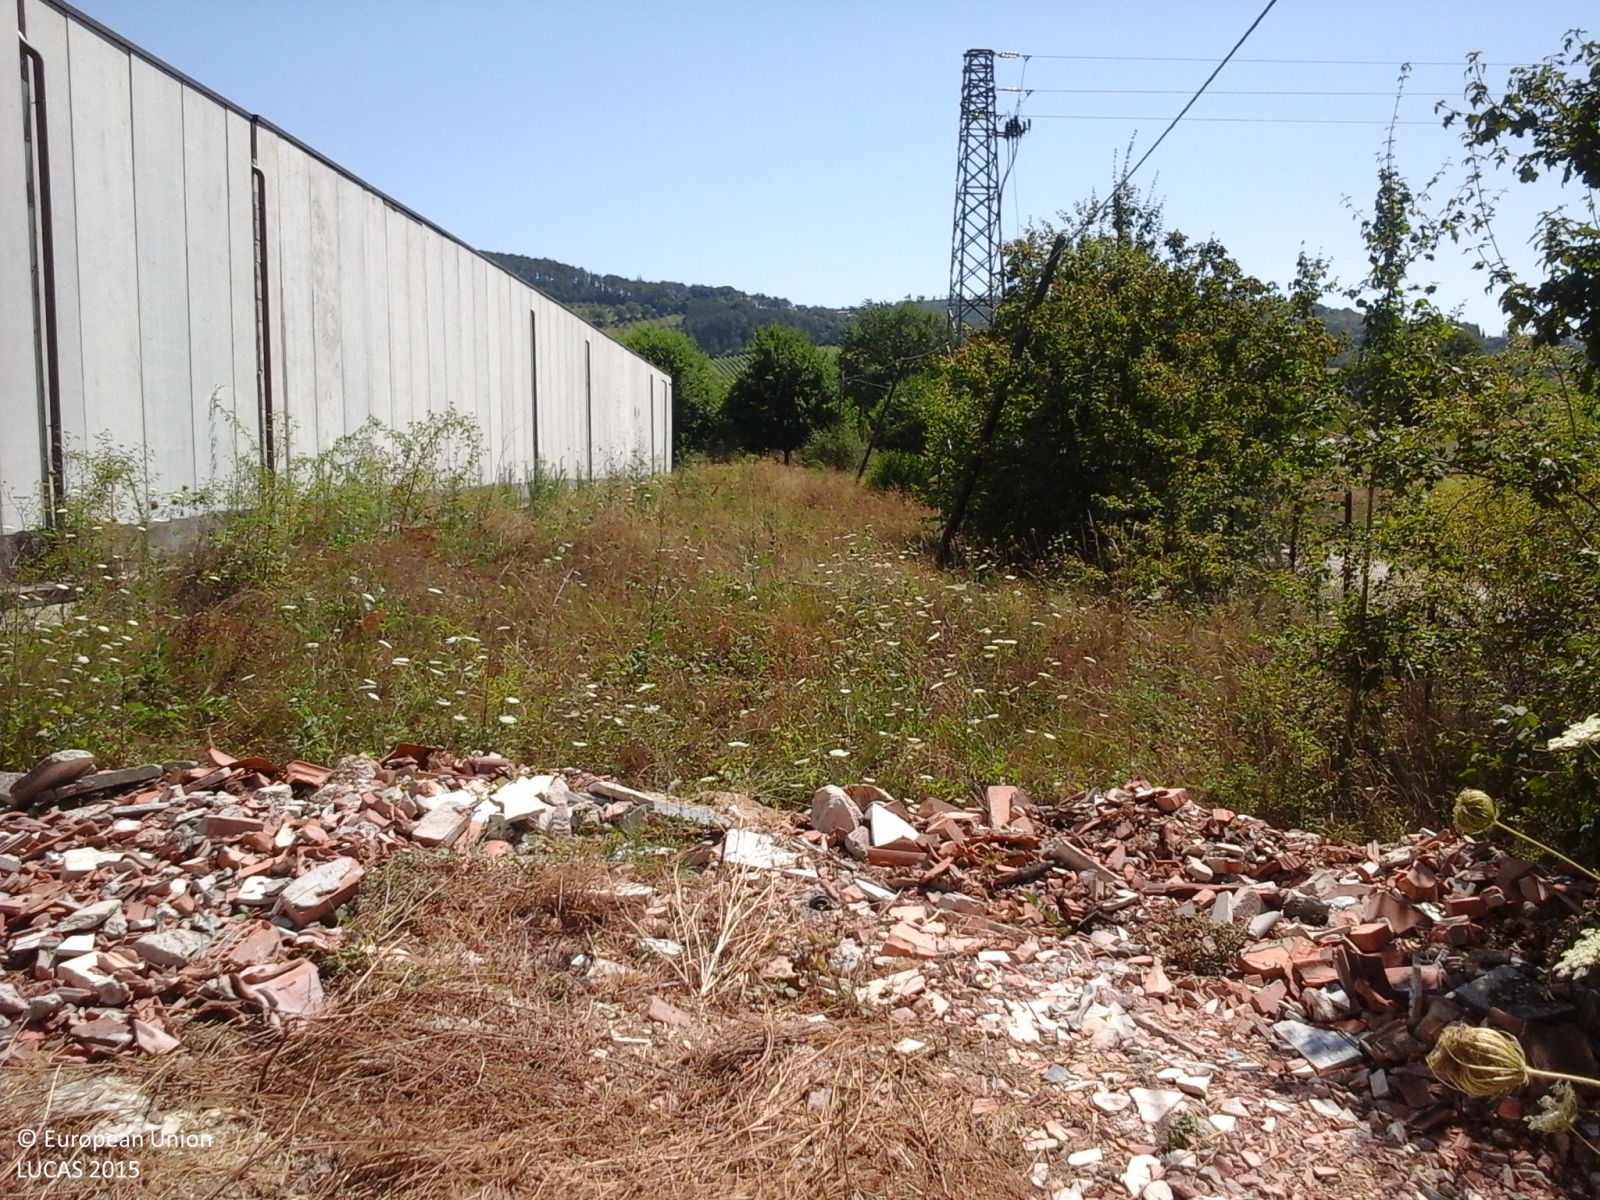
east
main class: Grassland
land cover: Grassland with sparse tree/shrub cover
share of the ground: > 75 %
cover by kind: herbaceous plants 95 %, broadleaved forest trees 5 %
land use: Community services
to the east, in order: Grassland with sparse tree/shrub cover; Fences; Lines of trees; Fences; Other fresh vegetables; Fences; Tracks; Cherry fruit; Grassland without tree/shrub cover
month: August
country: IT
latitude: 43.4597
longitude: 12.2557
